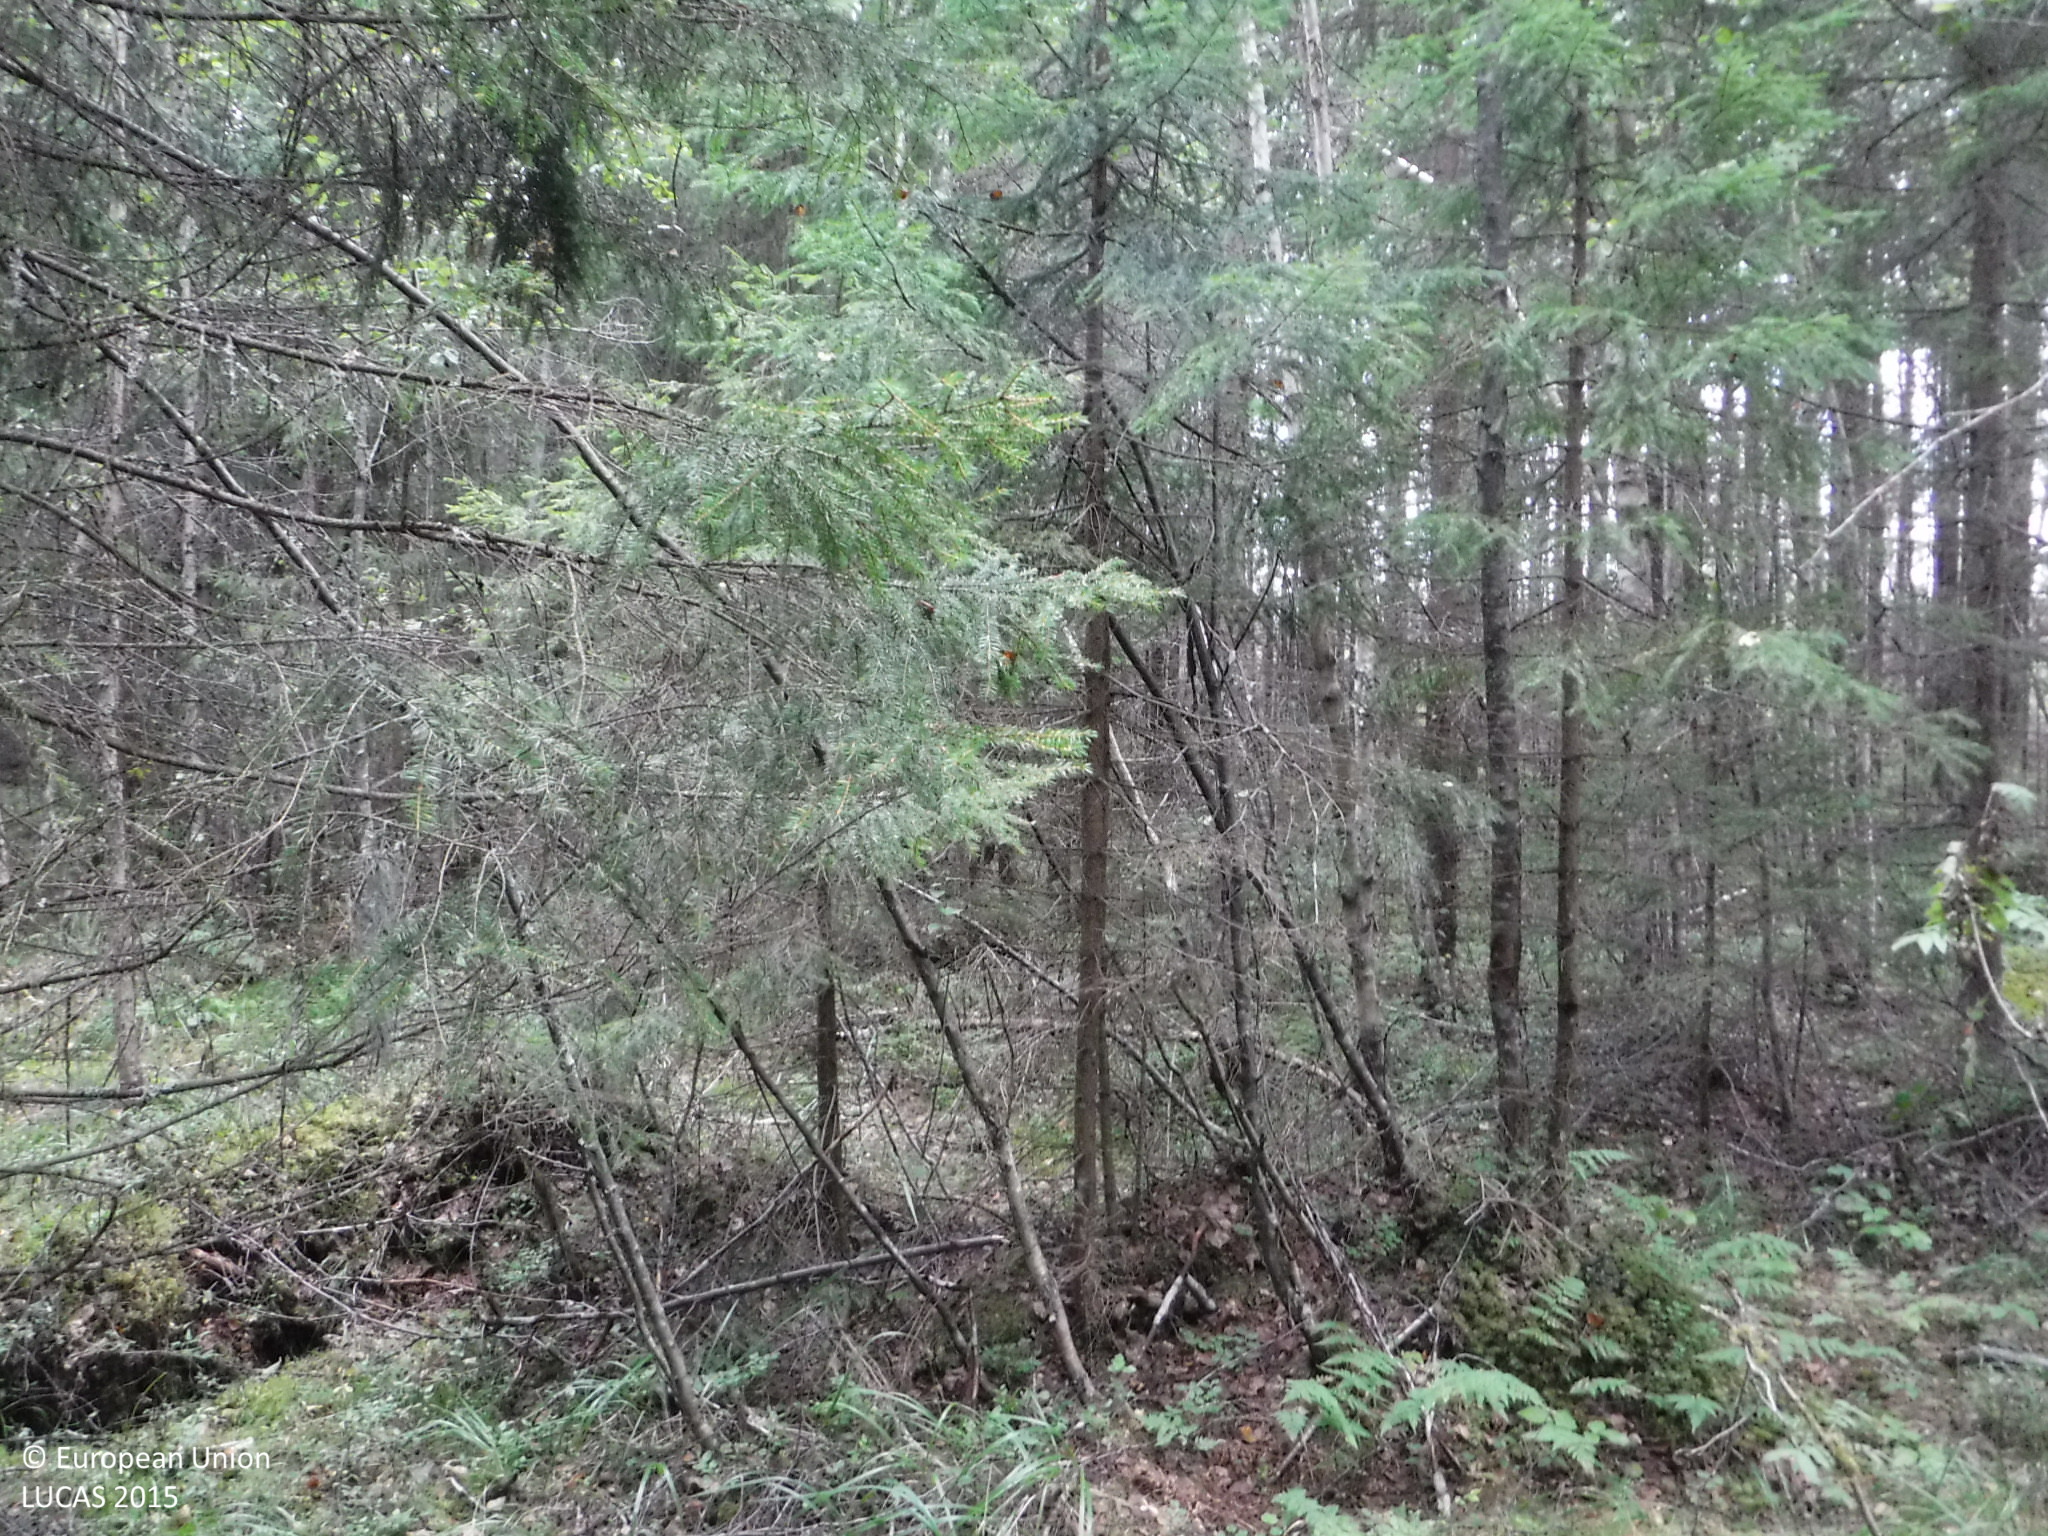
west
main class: Woodland
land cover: Spruce dominated mixed woodland
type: boreal forest
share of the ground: 50 - 75 %
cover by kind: coniferous forest trees 30 %, shrubs 25 %, broadleaved forest trees 20 %, lichens and mosses 20 %, herbaceous plants 5 %
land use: Forestry
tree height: > 5 m
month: August
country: FI
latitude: 61.2831
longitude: 21.8662
